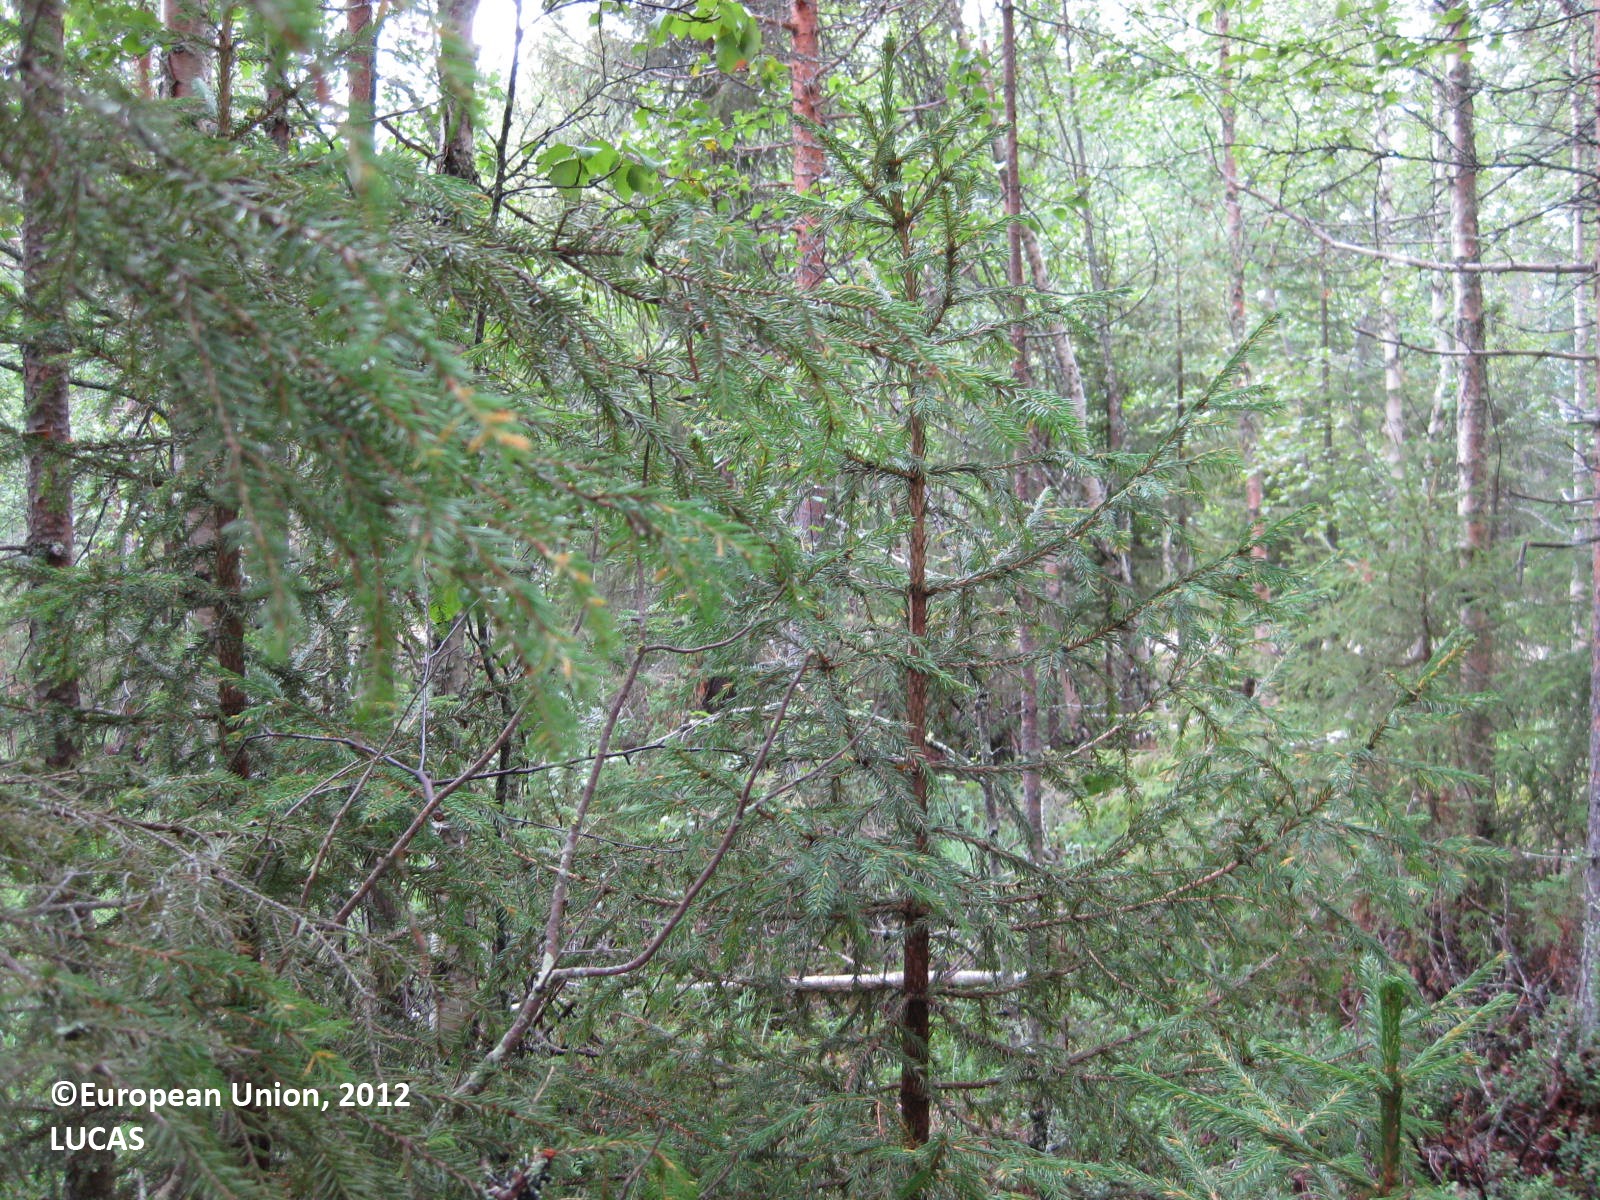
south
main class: Woodland
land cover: Pine dominated mixed woodland
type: boreal forest
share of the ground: > 75 %
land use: Forestry
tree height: > 5 m
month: August
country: FI
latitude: 66.0846
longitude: 28.2951
